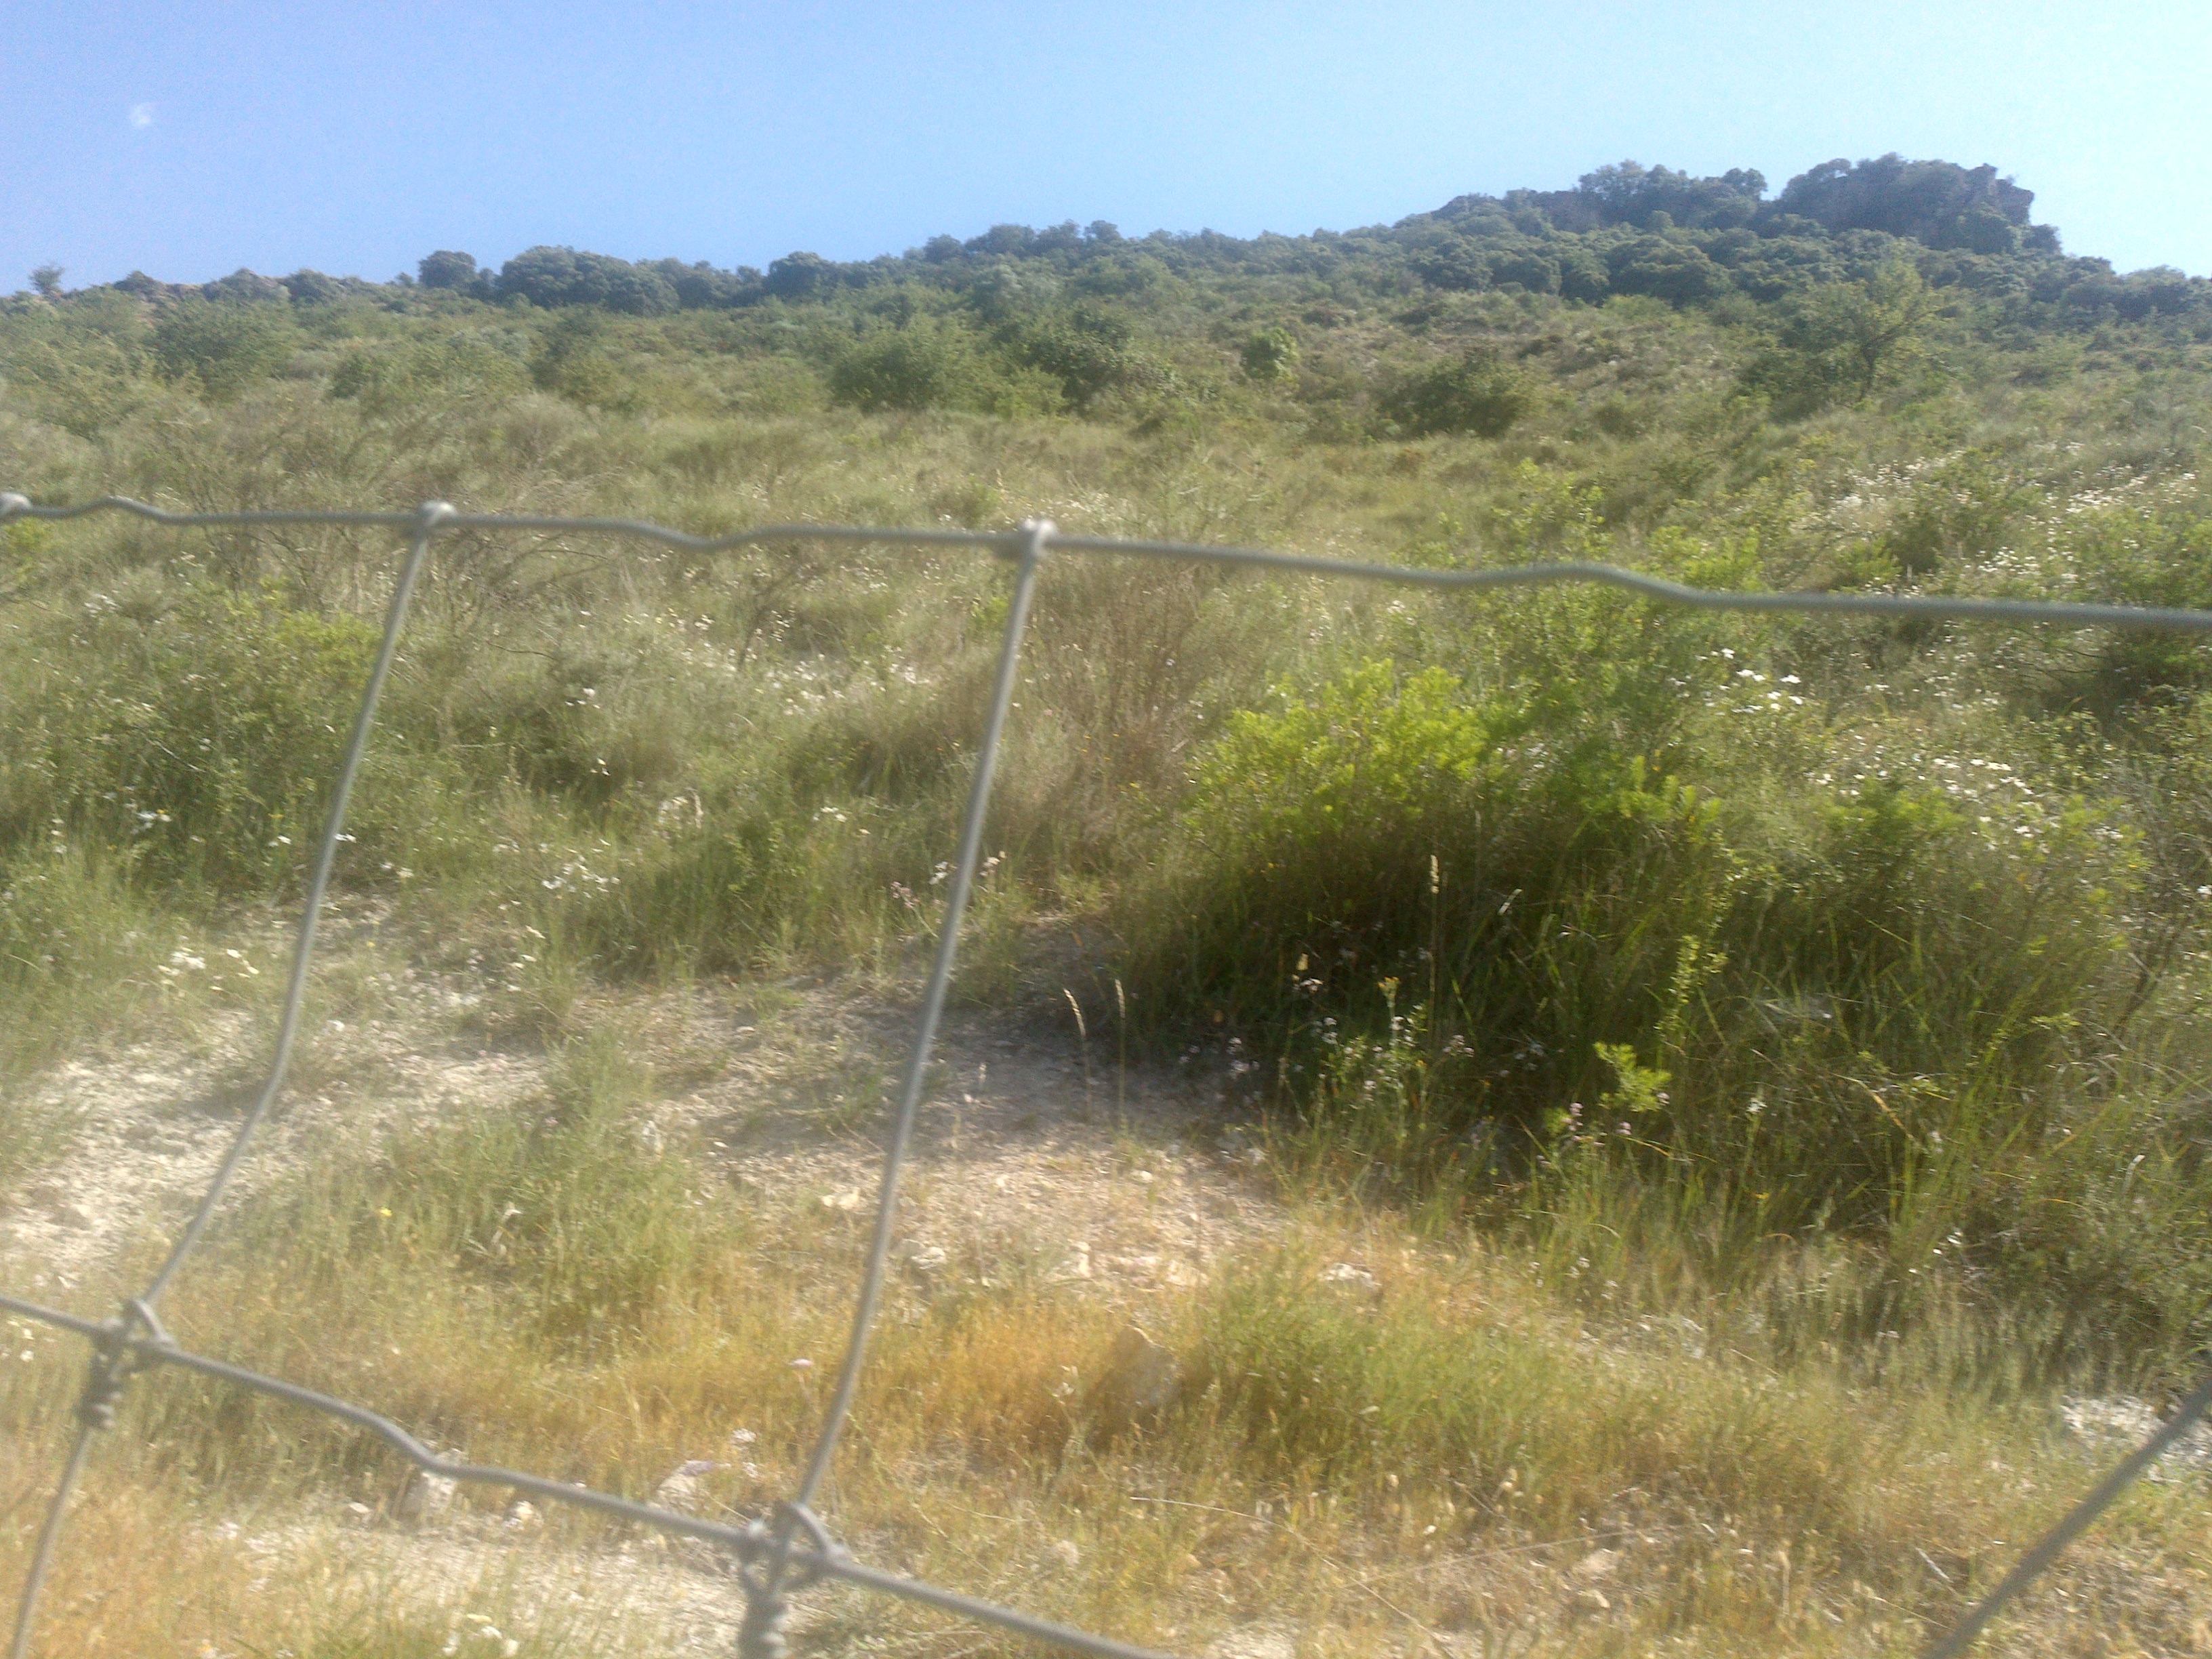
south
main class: Shrubland
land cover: Shrubland without tree cover
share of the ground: > 75 %
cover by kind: shrubs 75 %, herbaceous plants 20 %, unconsolidated bare surface 5 %
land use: Semi-natural and natural areas not in use
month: May
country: ES
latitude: 37.4587
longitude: -4.3711
